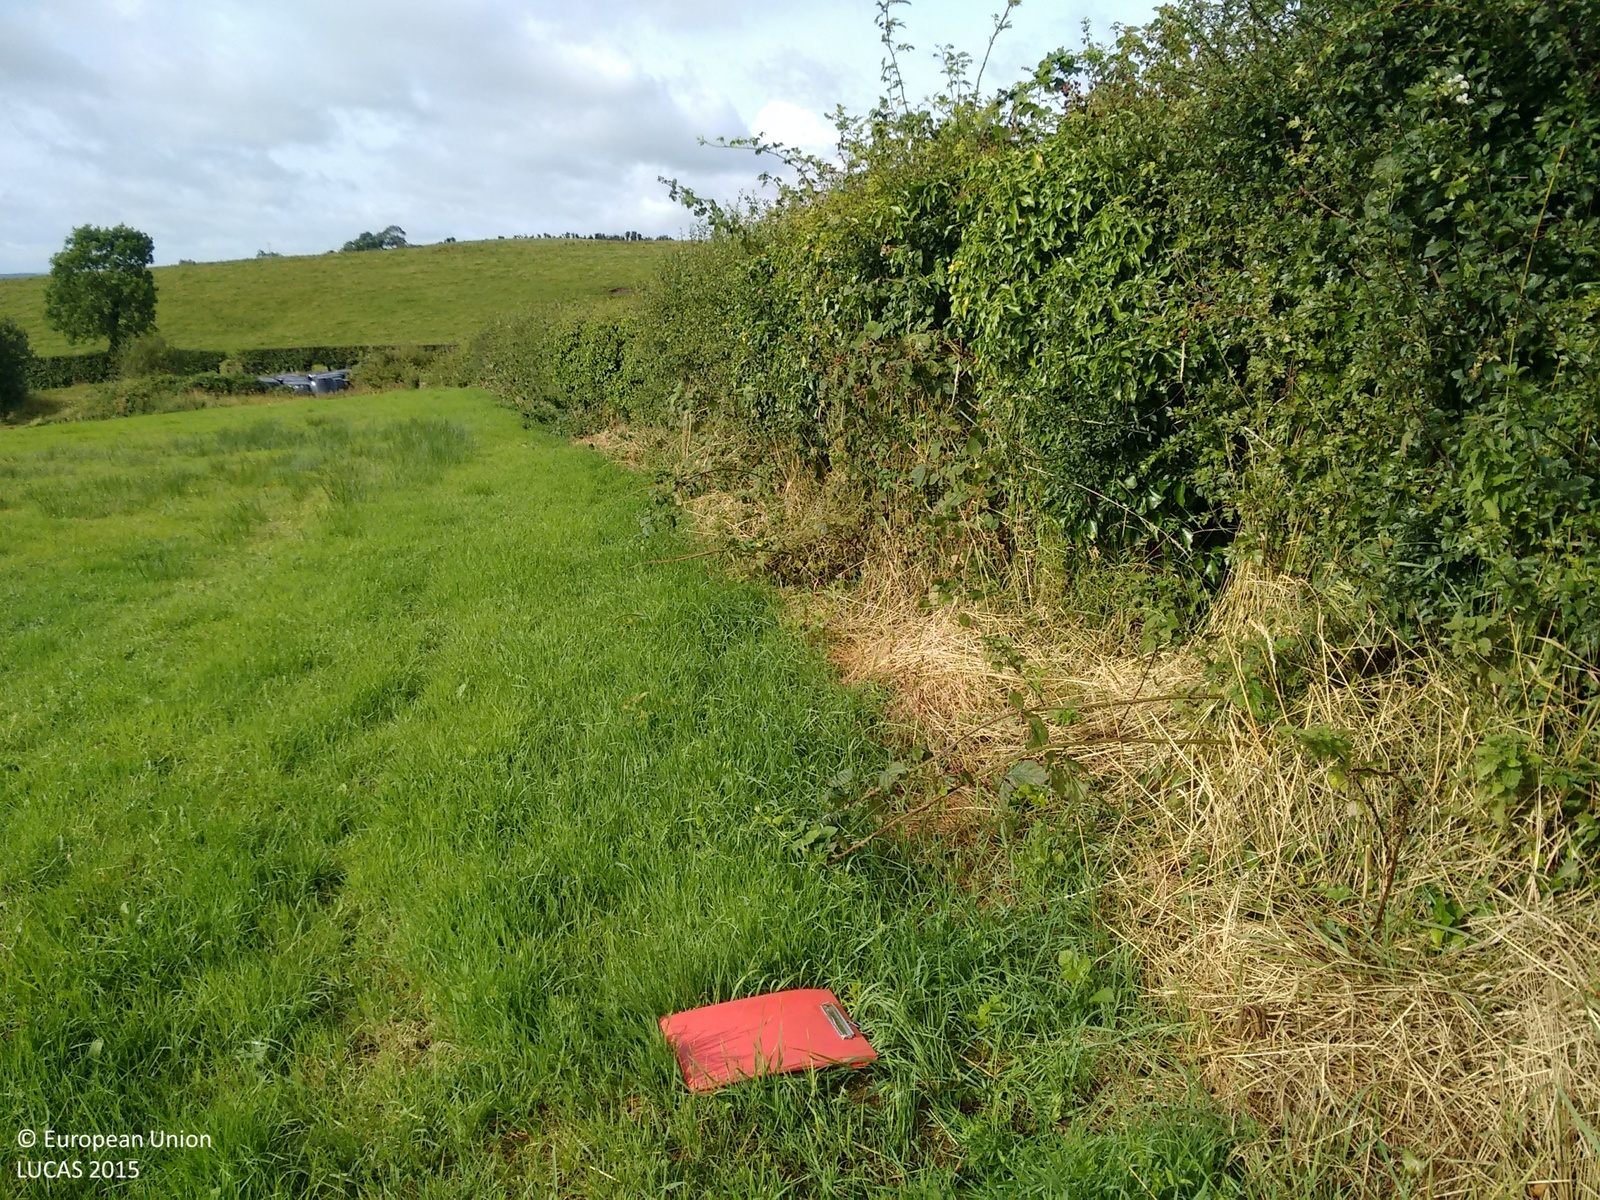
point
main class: Grassland
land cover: Grassland without tree/shrub cover
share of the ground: > 75 %
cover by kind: herbaceous plants 100 %
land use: Agriculture (excluding fallow land and kitchen gardens)
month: August
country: GB
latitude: 54.4715
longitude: -5.8926
